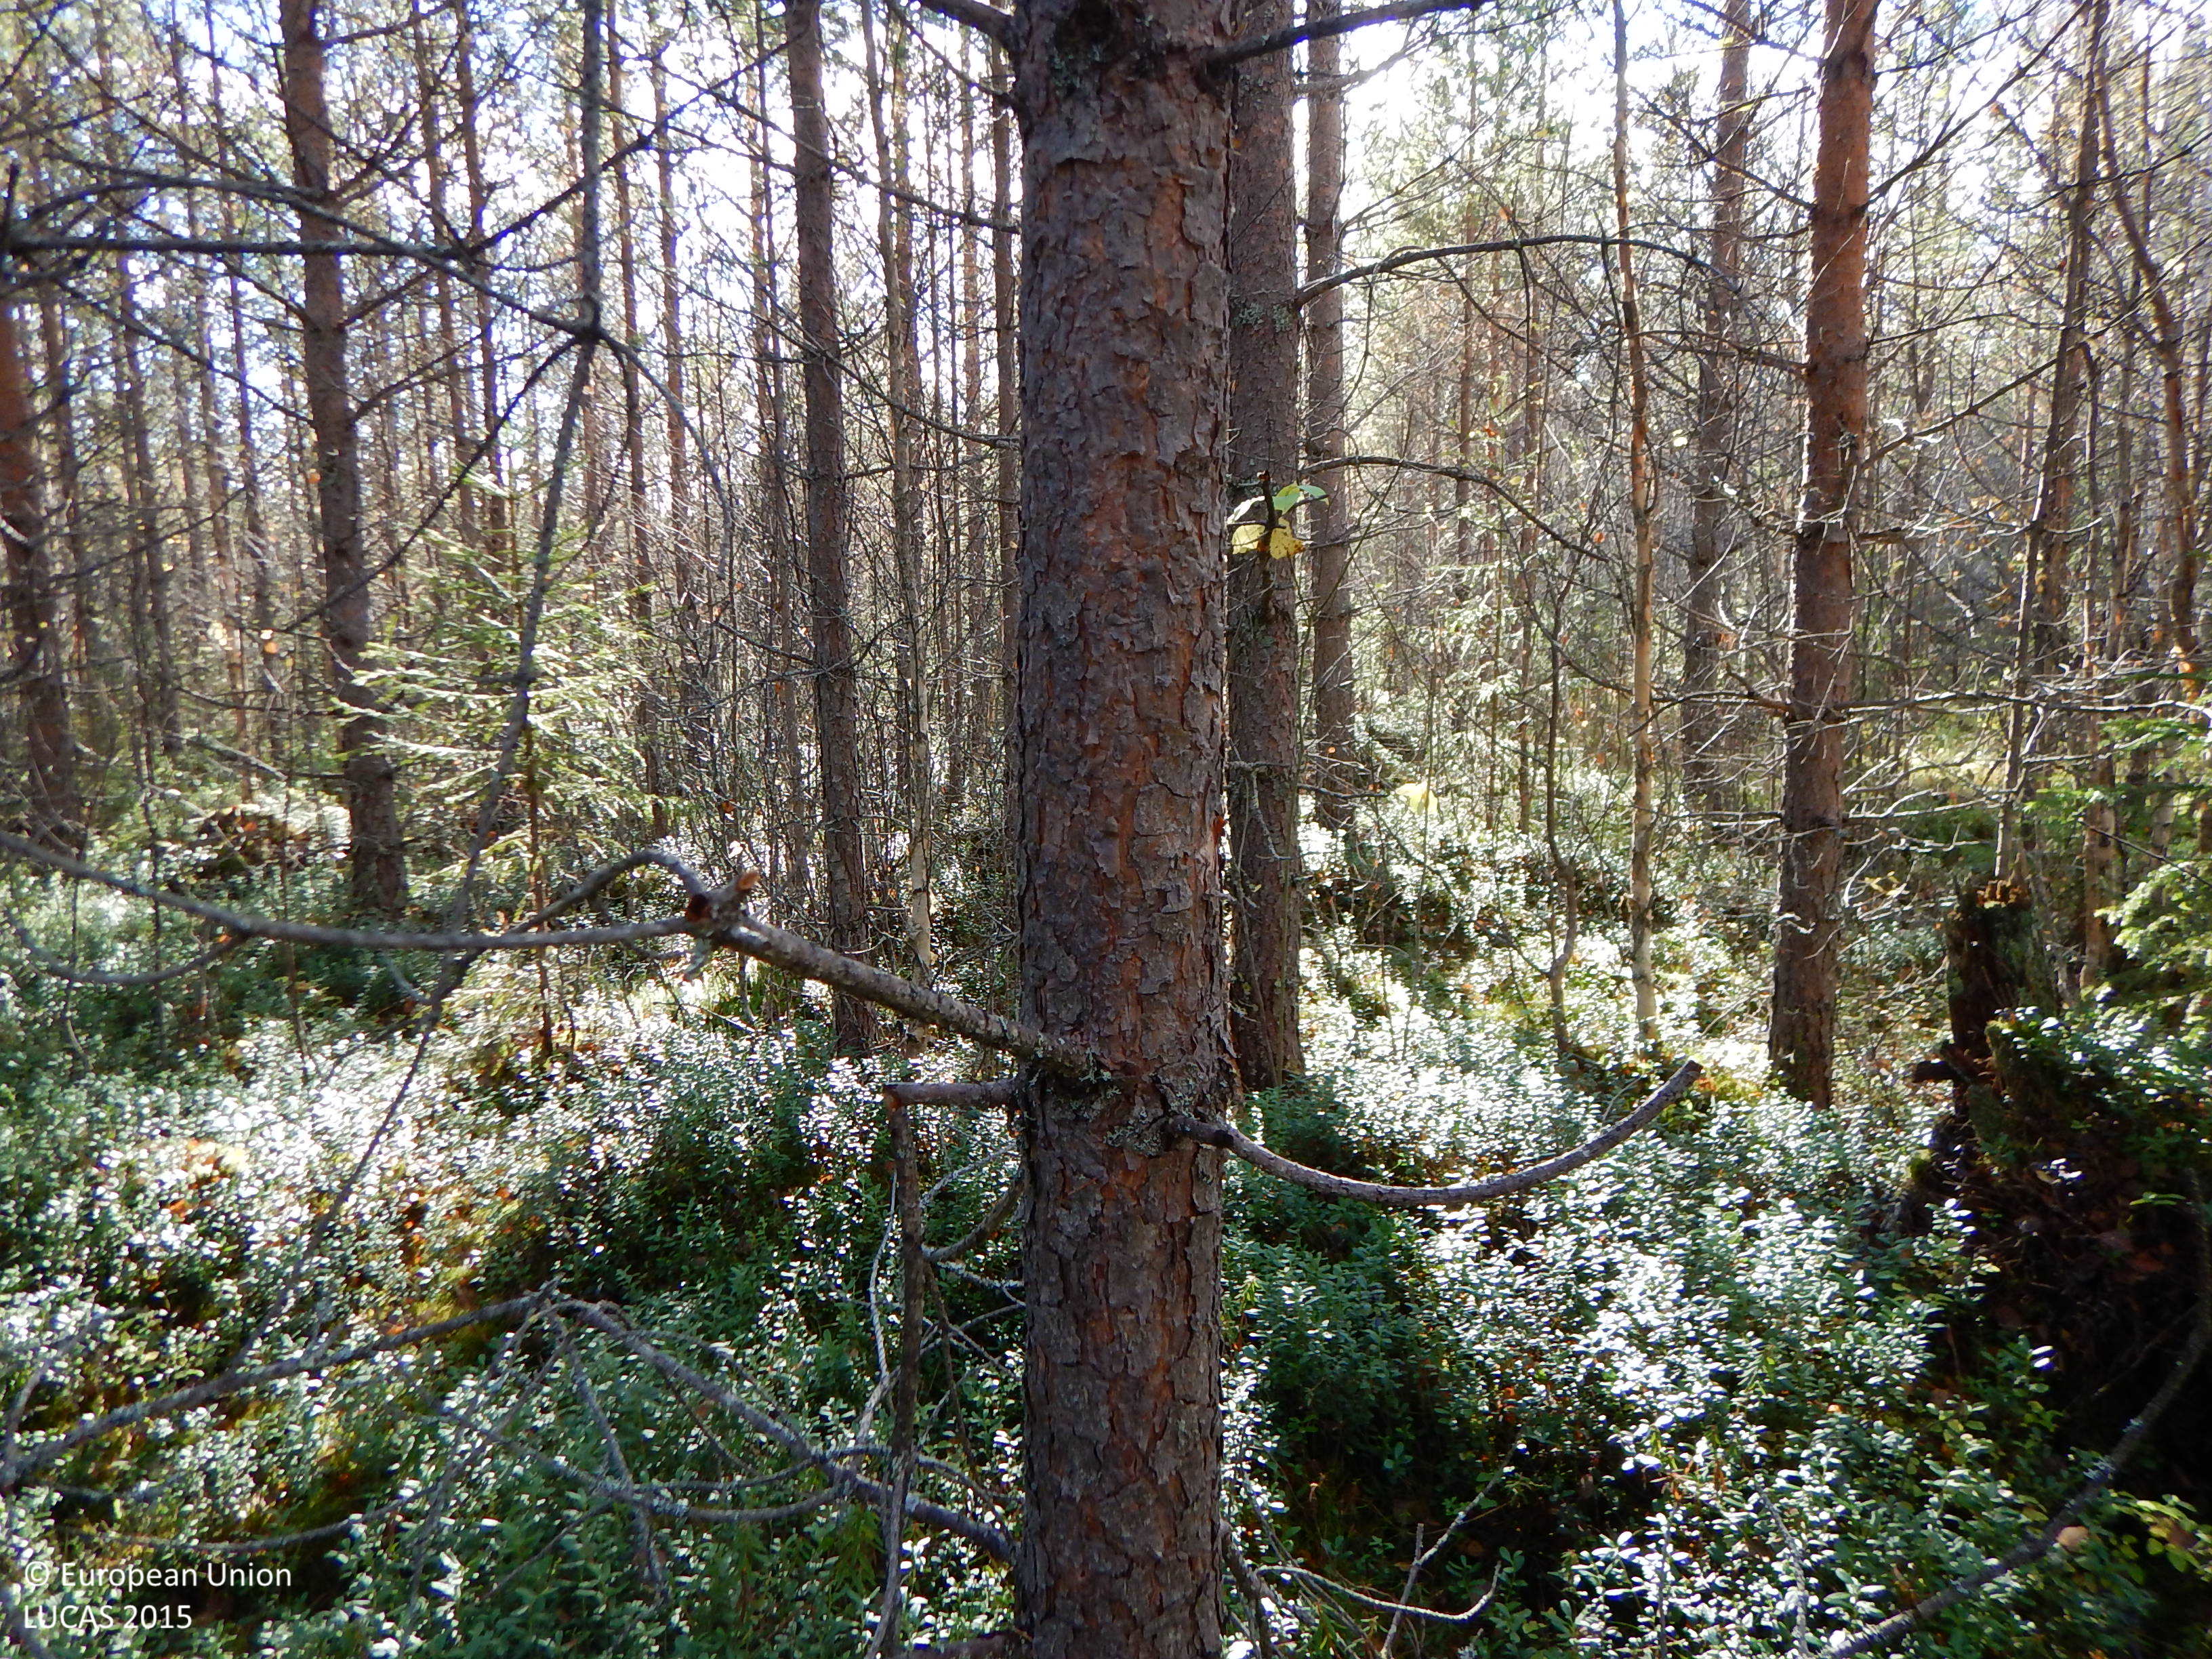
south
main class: Woodland
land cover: Pine dominated mixed woodland
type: boreal forest
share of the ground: 50 - 75 %
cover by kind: coniferous forest trees 50 %, broadleaved forest trees 20 %, shrubs 15 %, herbaceous plants 15 %
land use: Forestry
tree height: > 5 m
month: September
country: SE
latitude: 64.9299
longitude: 20.1445
